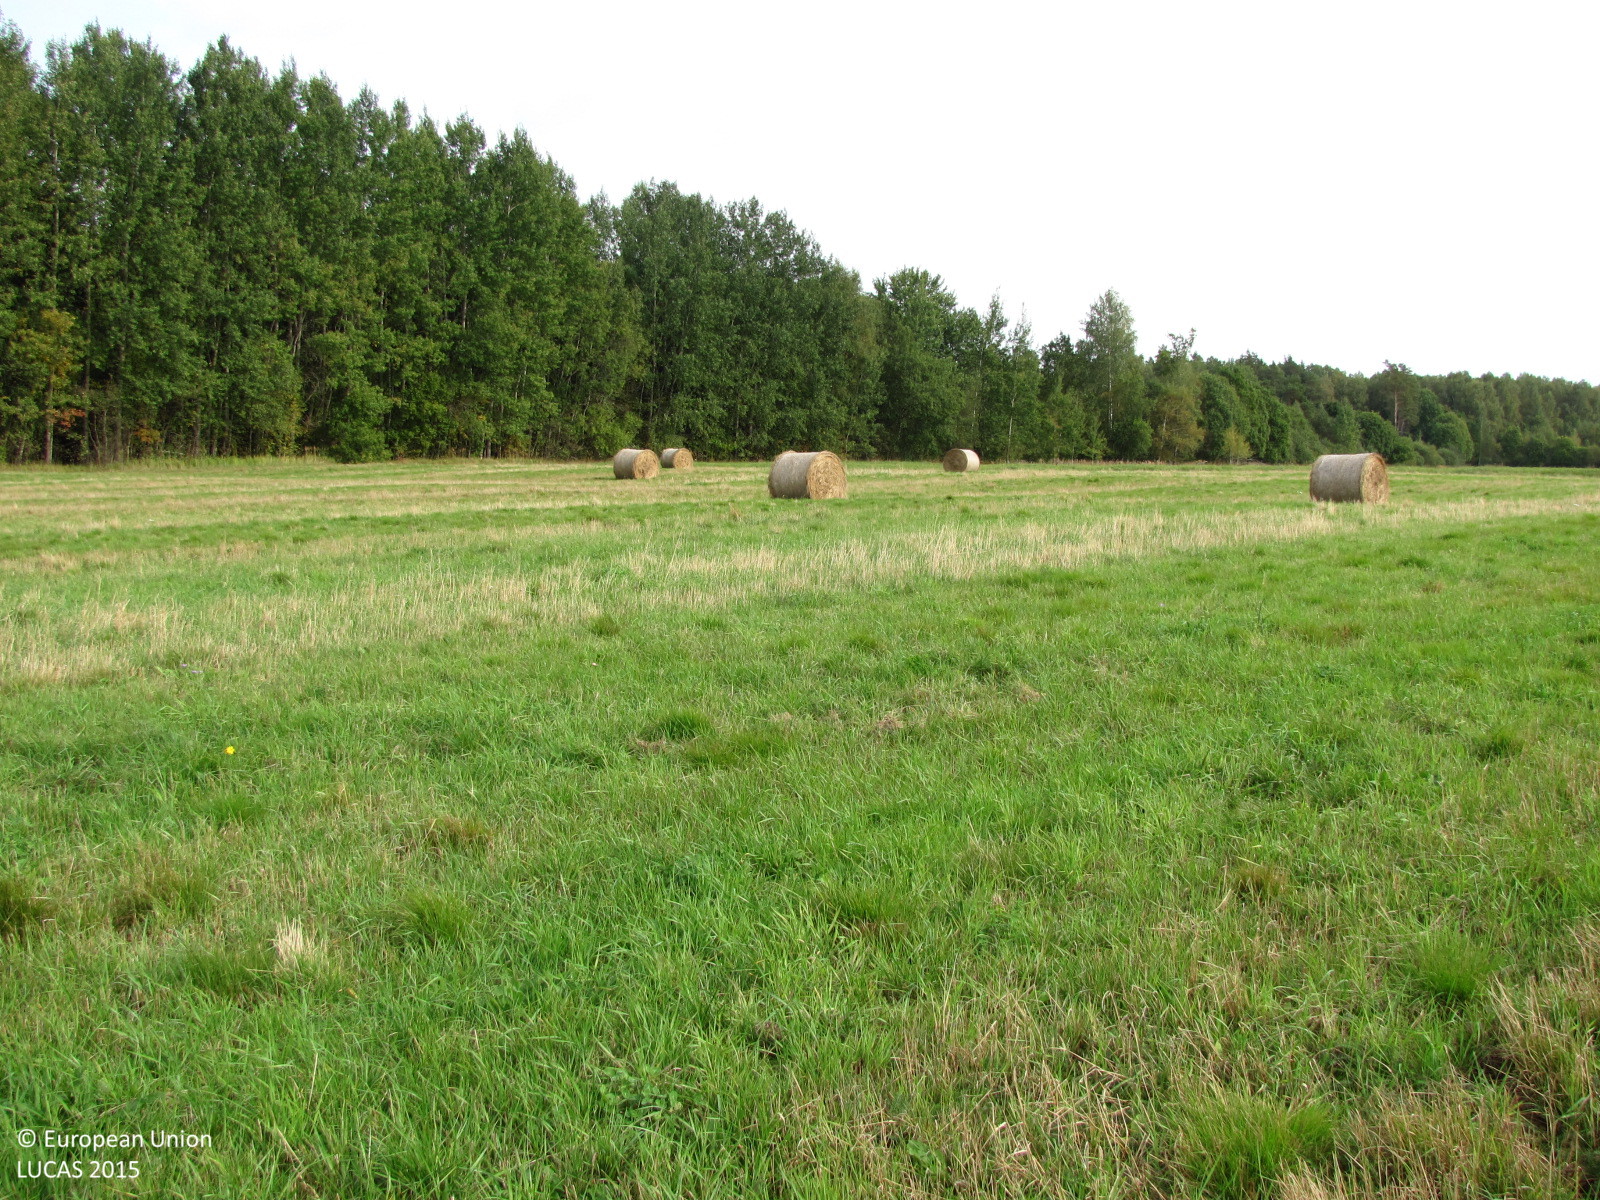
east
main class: Grassland
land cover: Grassland without tree/shrub cover
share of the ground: > 75 %
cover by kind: herbaceous plants 100 %
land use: Agriculture (excluding fallow land and kitchen gardens)
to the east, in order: Grassland without tree/shrub cover; Broadleaved woodland; Spruce dominated coniferous woodland
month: September
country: LV
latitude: 57.1600
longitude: 24.5950
